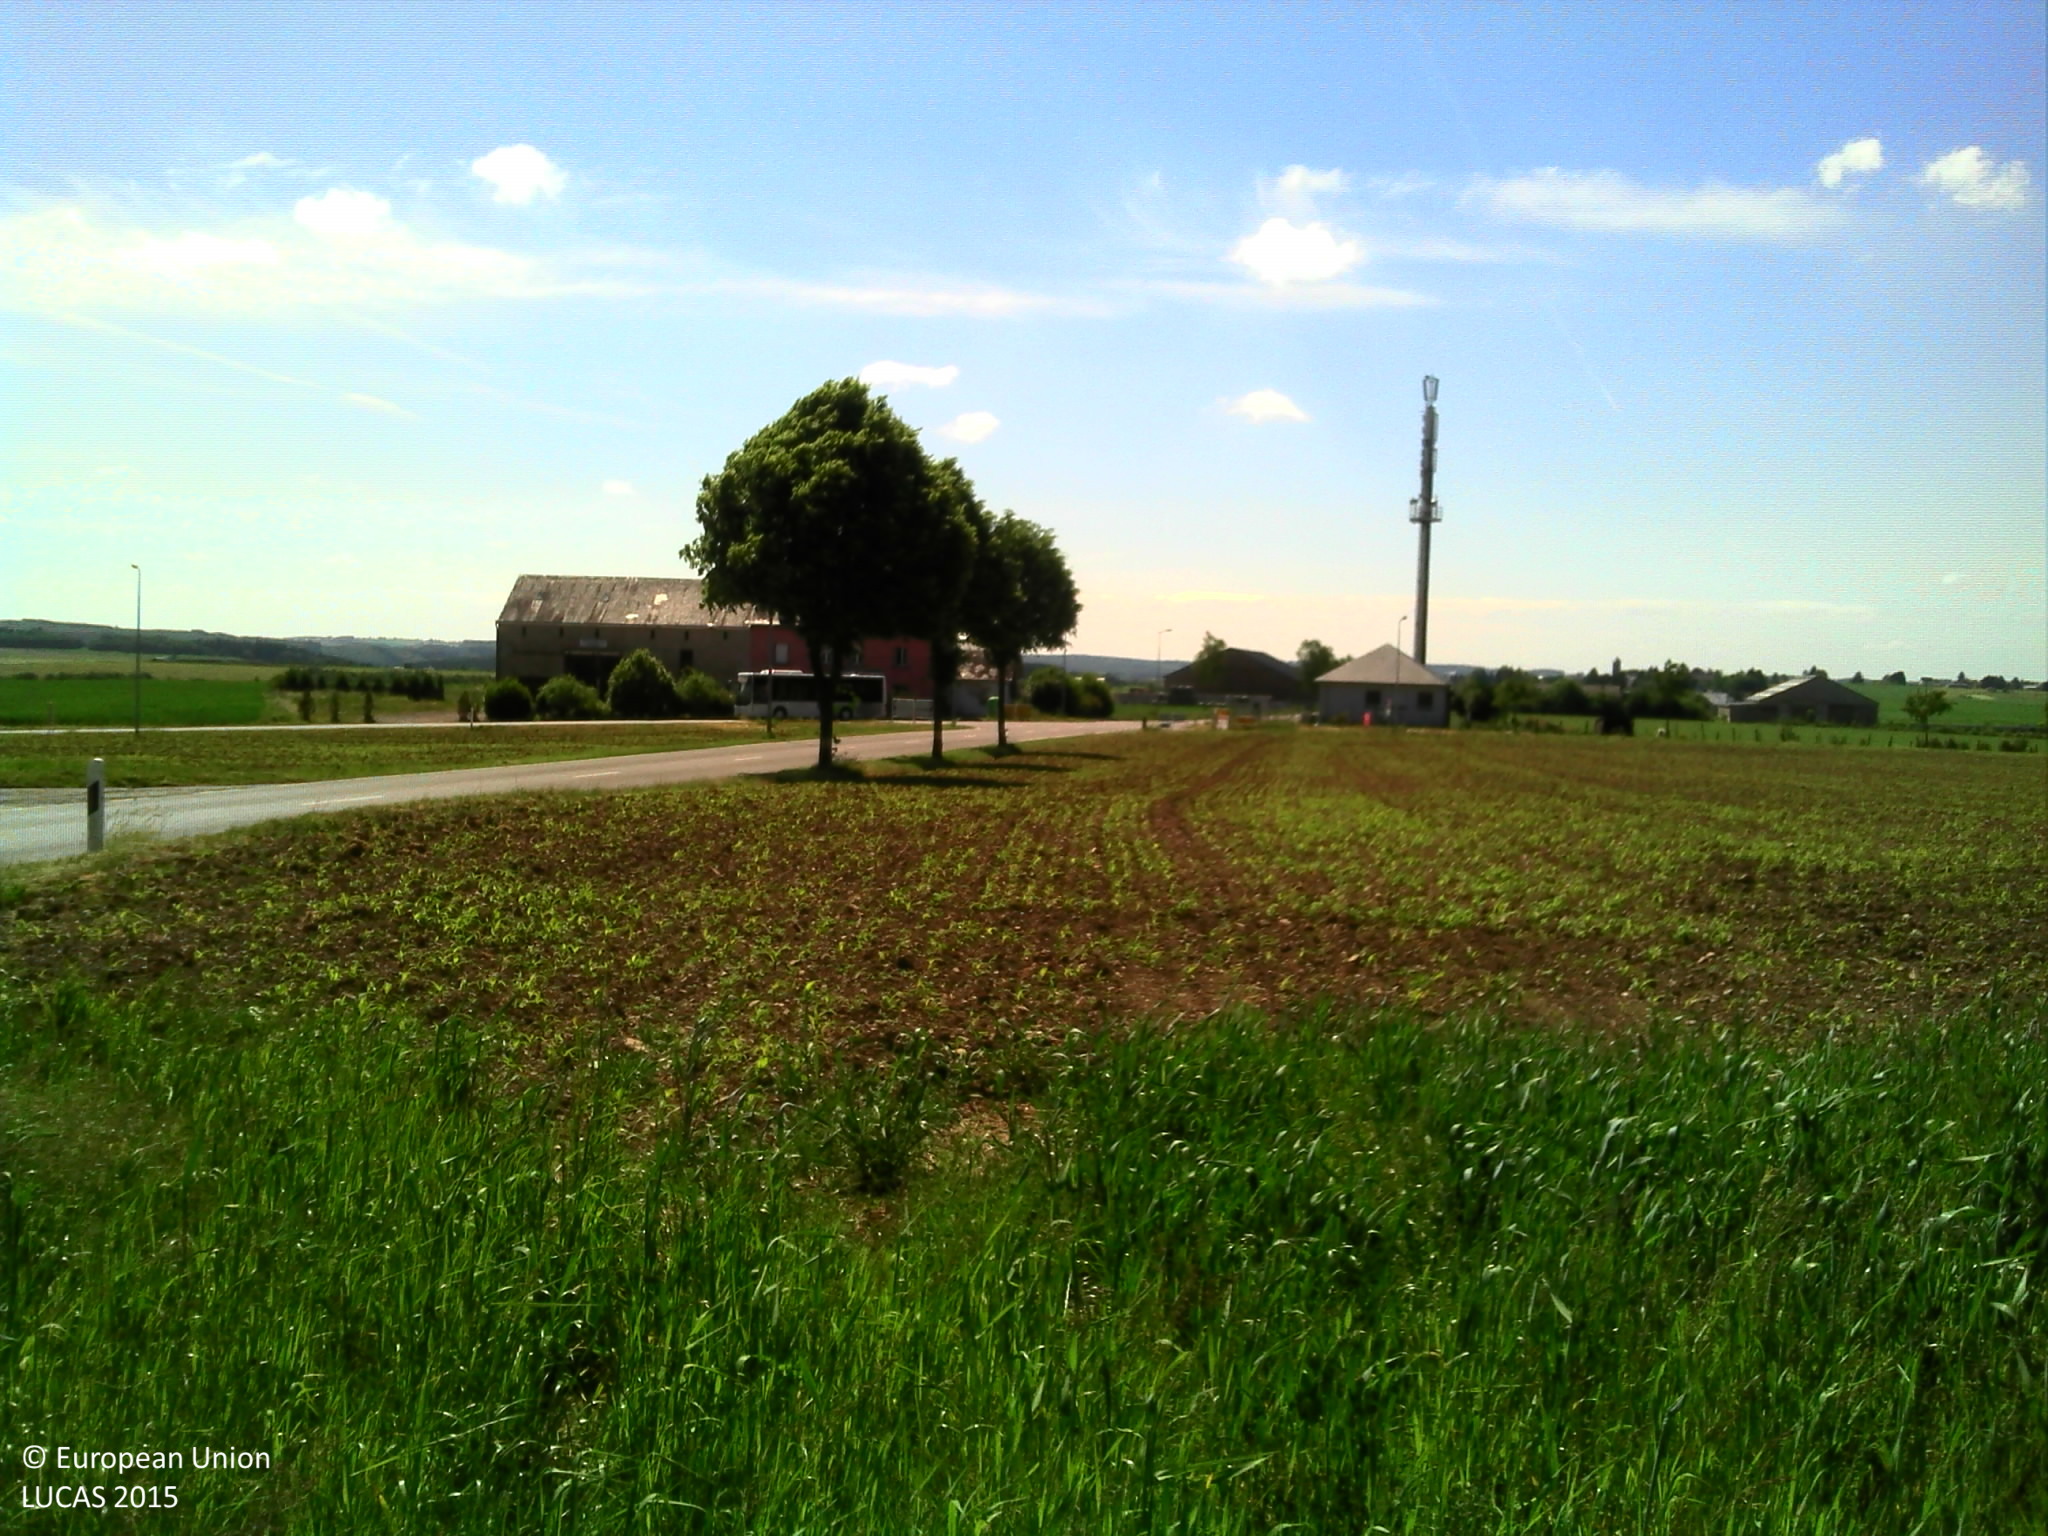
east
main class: Cropland
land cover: Common wheat
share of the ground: > 75 %
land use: Agriculture (excluding fallow land and kitchen gardens)
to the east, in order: Common wheat; Grass margins; Paved roads, cycling and walking lanes; Grass margins; Maize; Tracks; Grass margins; Maize; Grass margins; Paved roads, cycling and walking lanes; Grass margins; Lines of trees; Common wheat
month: June
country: LU
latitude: 49.9091
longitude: 5.8075
